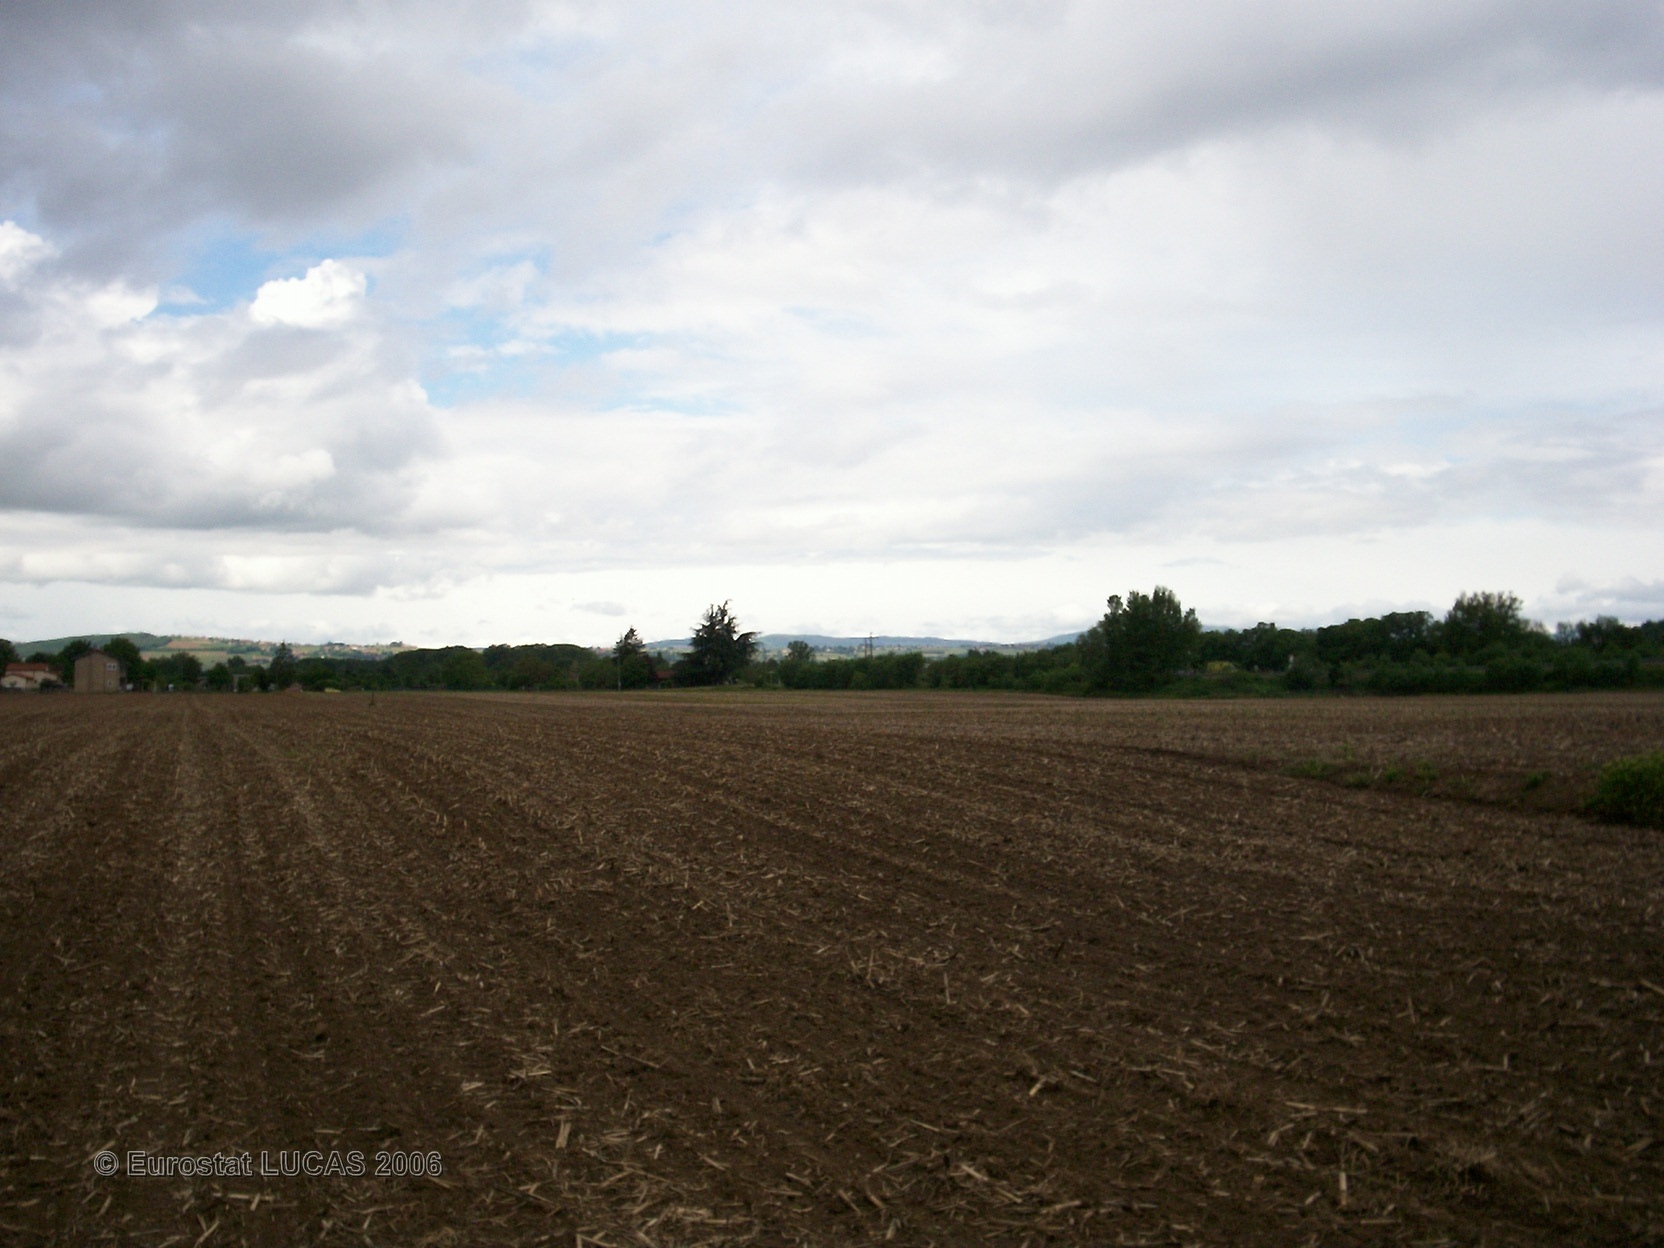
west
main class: Cropland
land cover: Maize
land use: Agriculture (excluding fallow land and kitchen gardens)
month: May
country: FR
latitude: 45.9350
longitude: 4.7797
